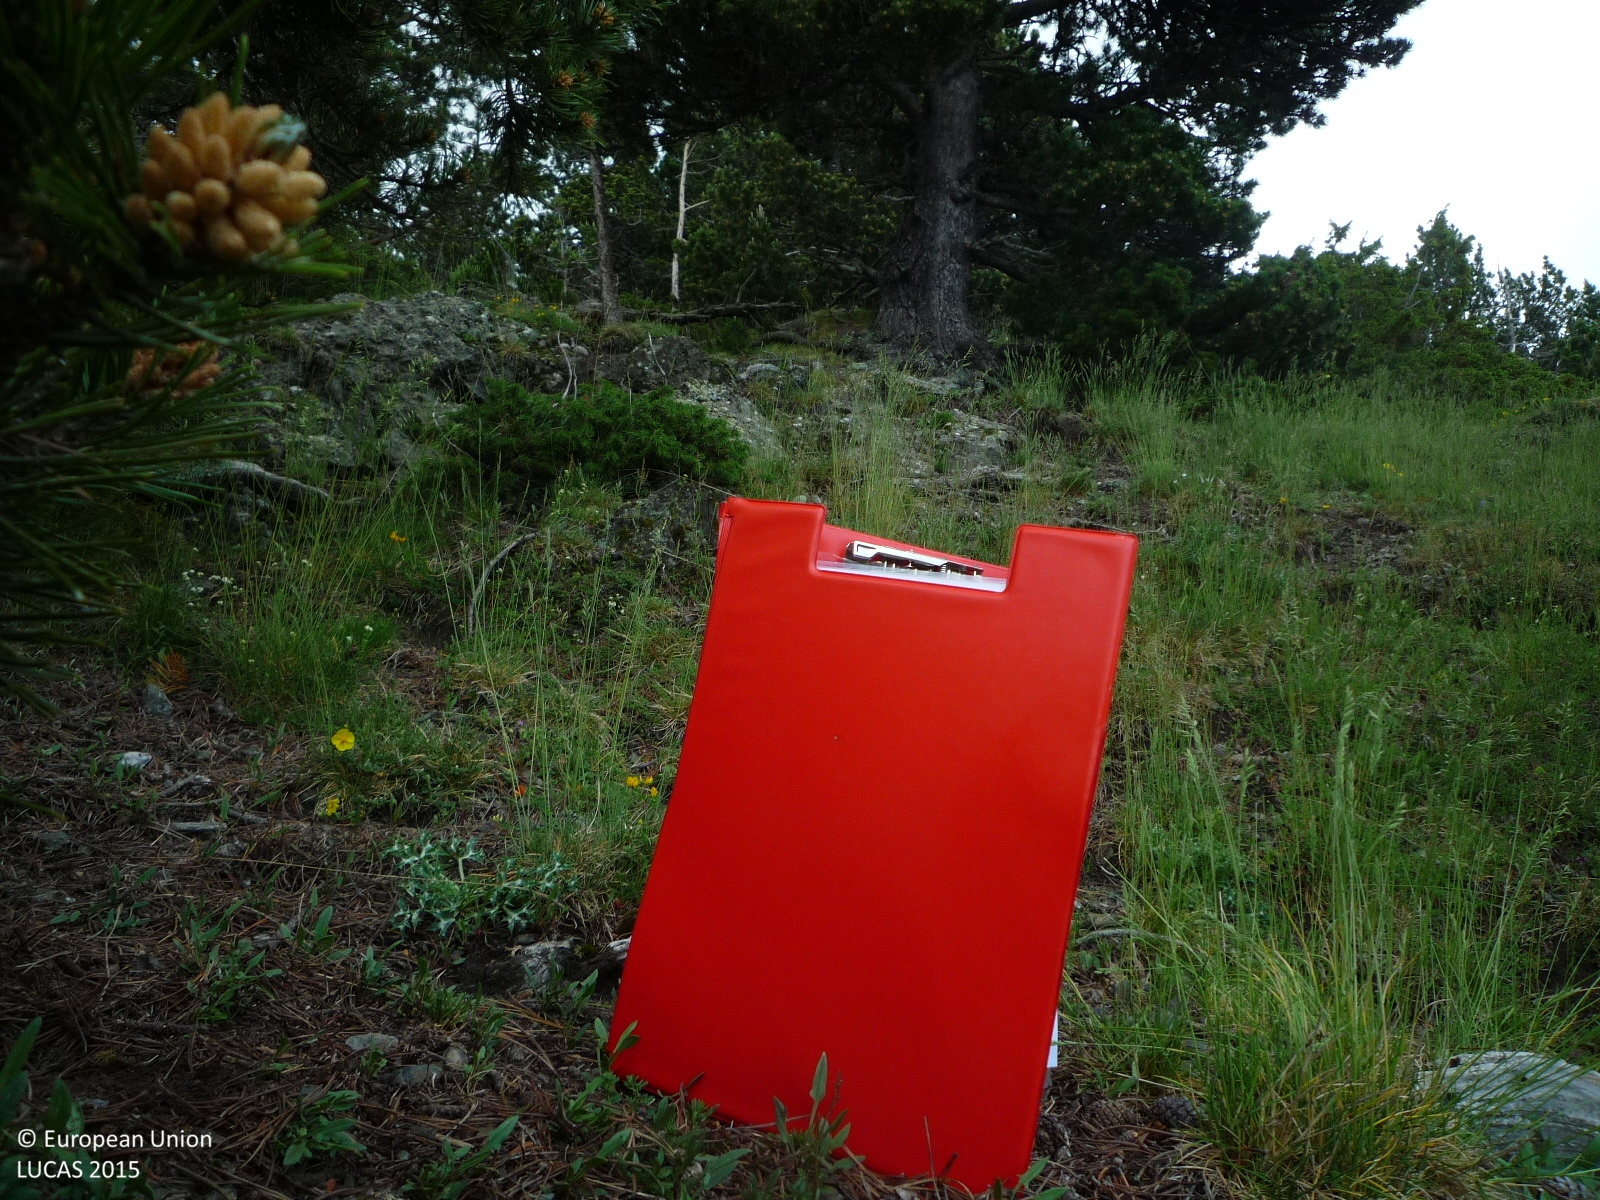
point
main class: Woodland
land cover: Pine dominated coniferous woodland
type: alpine coniferous forest
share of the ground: > 75 %
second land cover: Grassland without tree/shrub cover
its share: 50 - 75 %
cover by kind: coniferous forest trees 70 %, herbaceous plants 30 %
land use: Forestry
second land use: Agriculture (excluding fallow land and kitchen gardens)
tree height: < 5 m
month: June
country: ES
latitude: 42.2927
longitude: 1.8979
